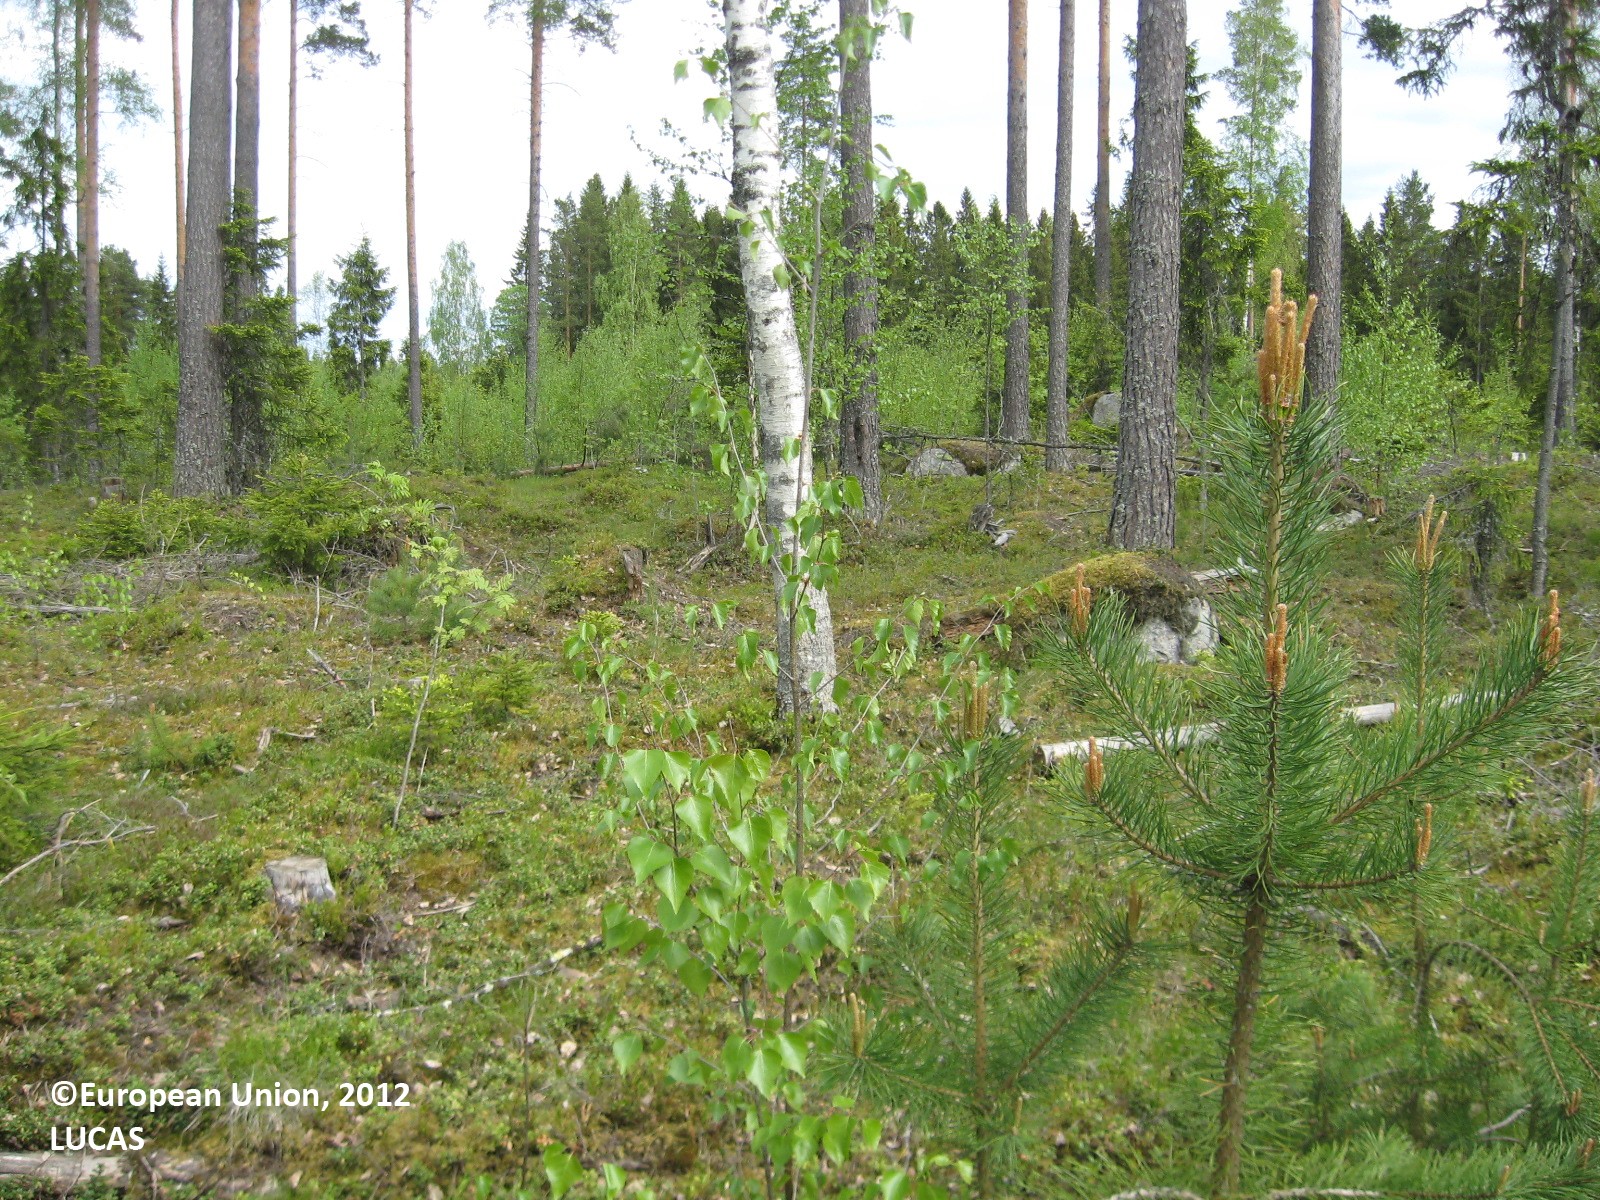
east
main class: Woodland
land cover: Other mixed woodland
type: boreal forest
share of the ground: 25 - 50 %
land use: Forestry
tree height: < 5 m
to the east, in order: Other mixed woodland; Pine dominated coniferous woodland; Other mixed woodland; Ditches and canals; Grassland without tree/shrub cover; Ditches and canals; Spruce dominated coniferous woodland; Paved roads, cycling and walking lanes; Pine dominated coniferous woodland; Grass margins; Paved roads, cycling and walking lanes; Grass margins; Barley
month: May
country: FI
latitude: 61.8411
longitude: 22.6183
